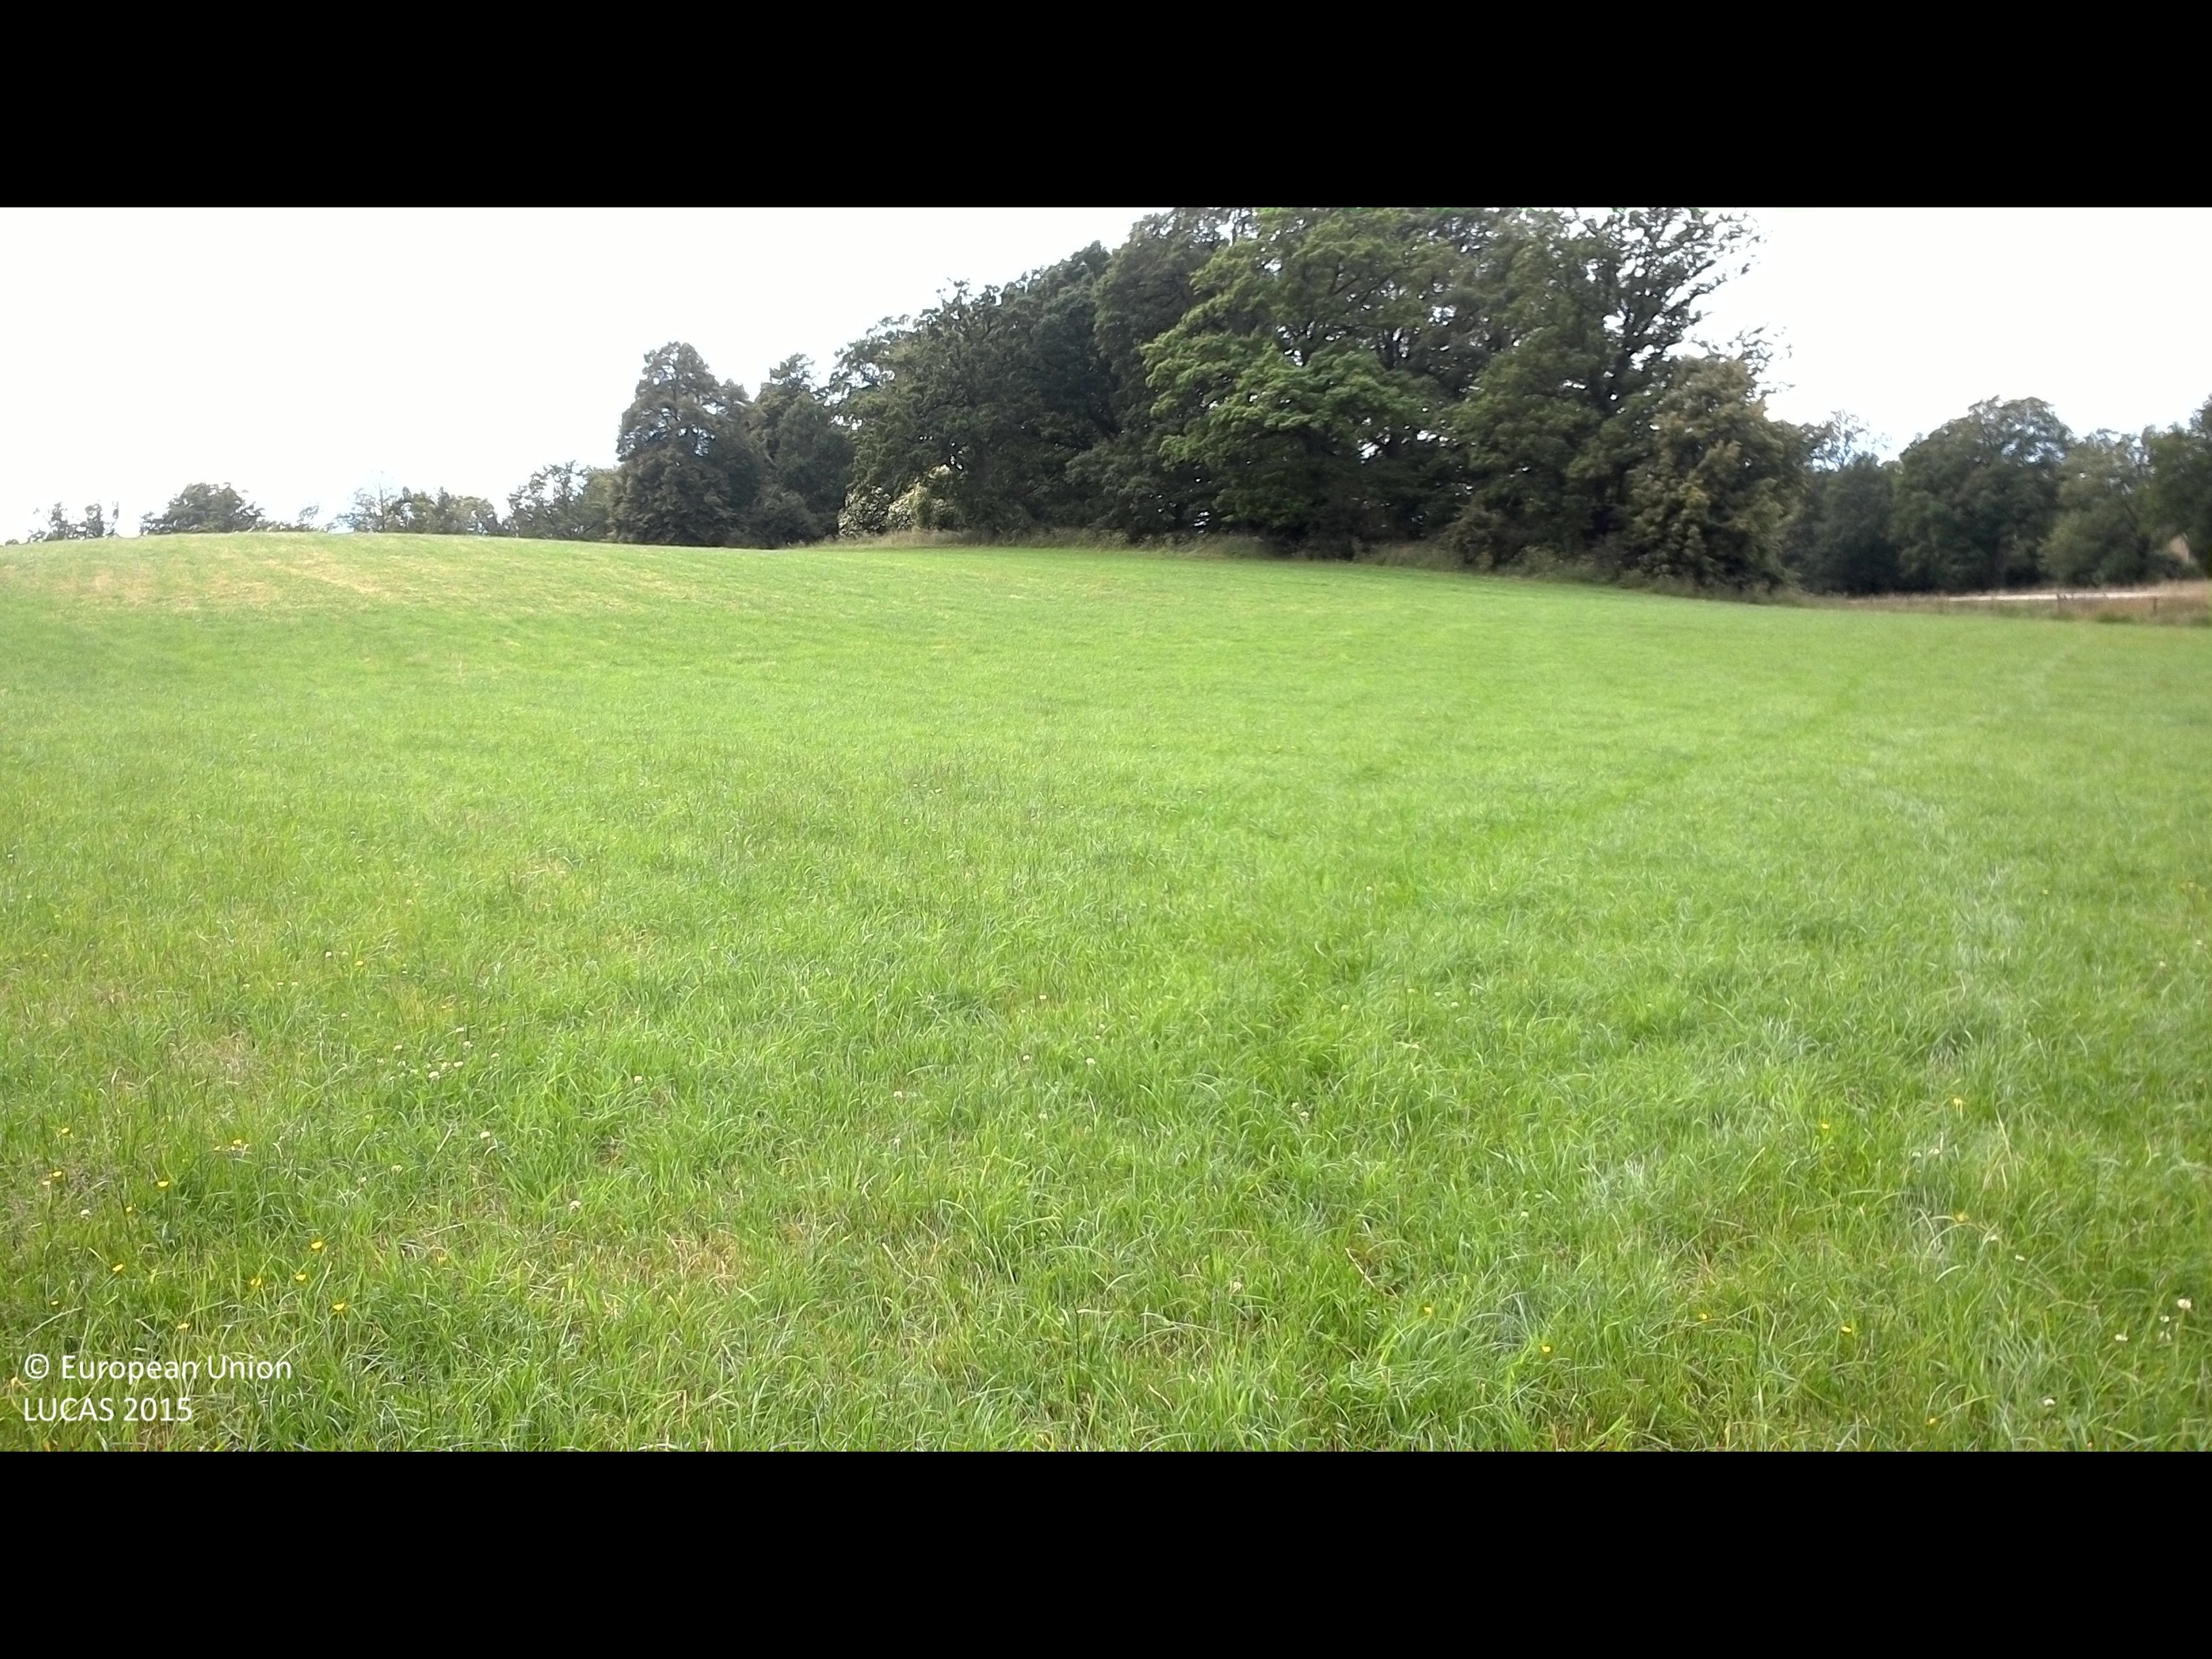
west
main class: Cropland
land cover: Temporary grasslands
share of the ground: > 75 %
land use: Agriculture (excluding fallow land and kitchen gardens)
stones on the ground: < 10 %
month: June
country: SE
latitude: 56.4403
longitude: 16.0830
